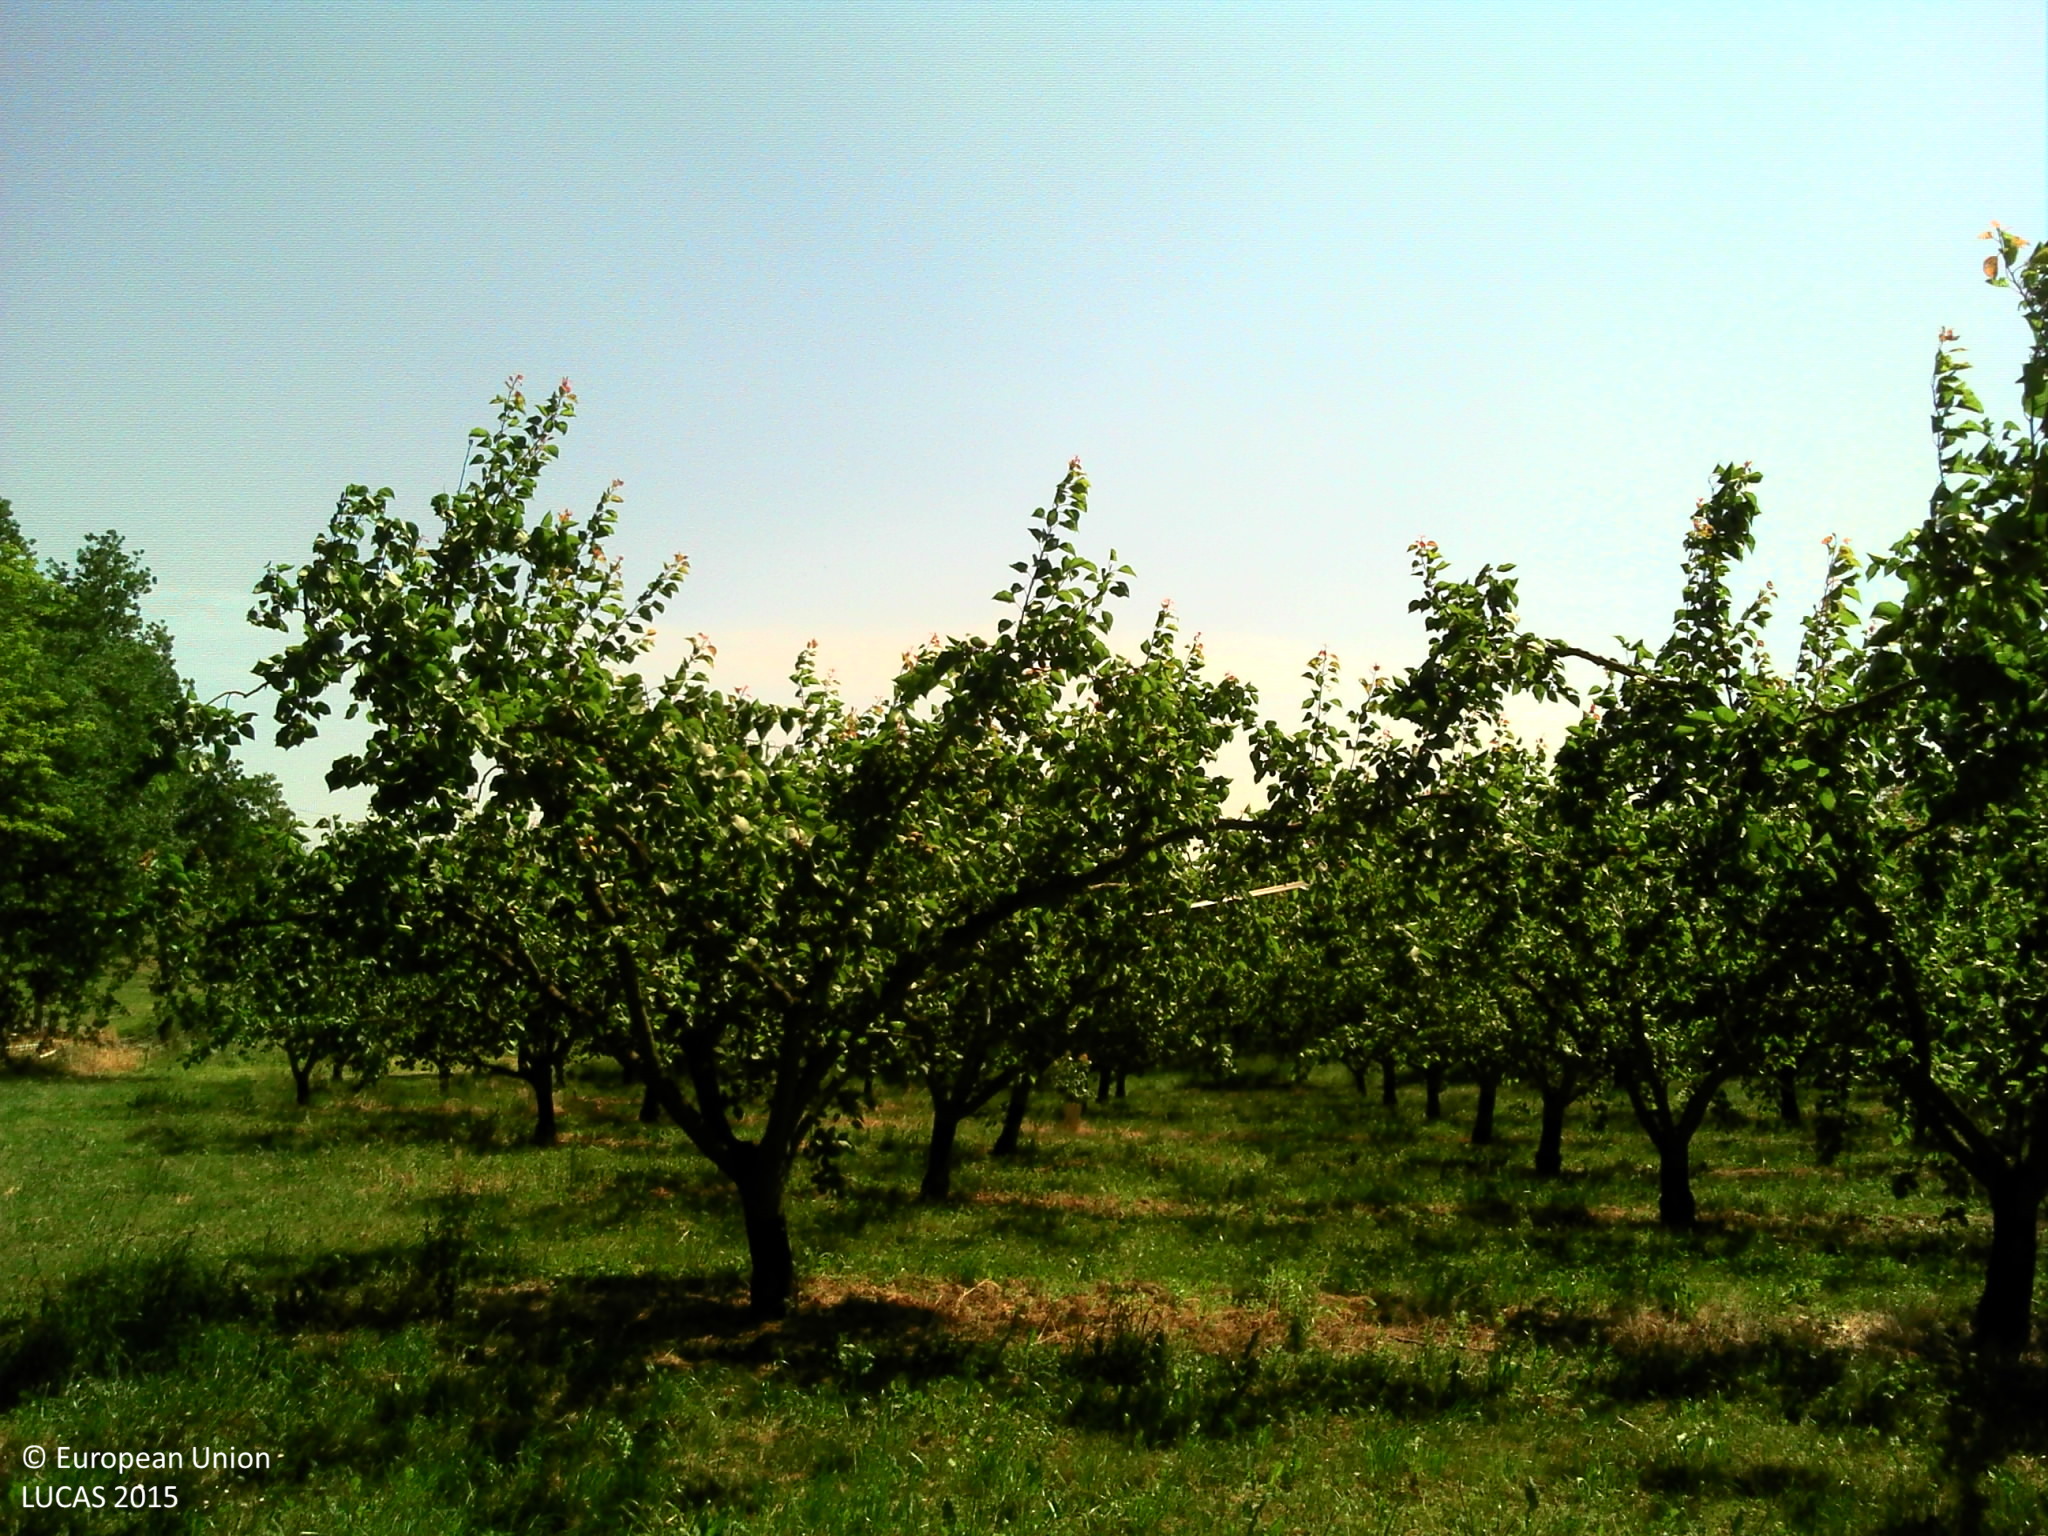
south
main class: Grassland
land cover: Grassland without tree/shrub cover
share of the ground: > 75 %
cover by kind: herbaceous plants 100 %
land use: Agriculture (excluding fallow land and kitchen gardens)
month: May
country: FR
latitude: 45.0748
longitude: 4.9117
